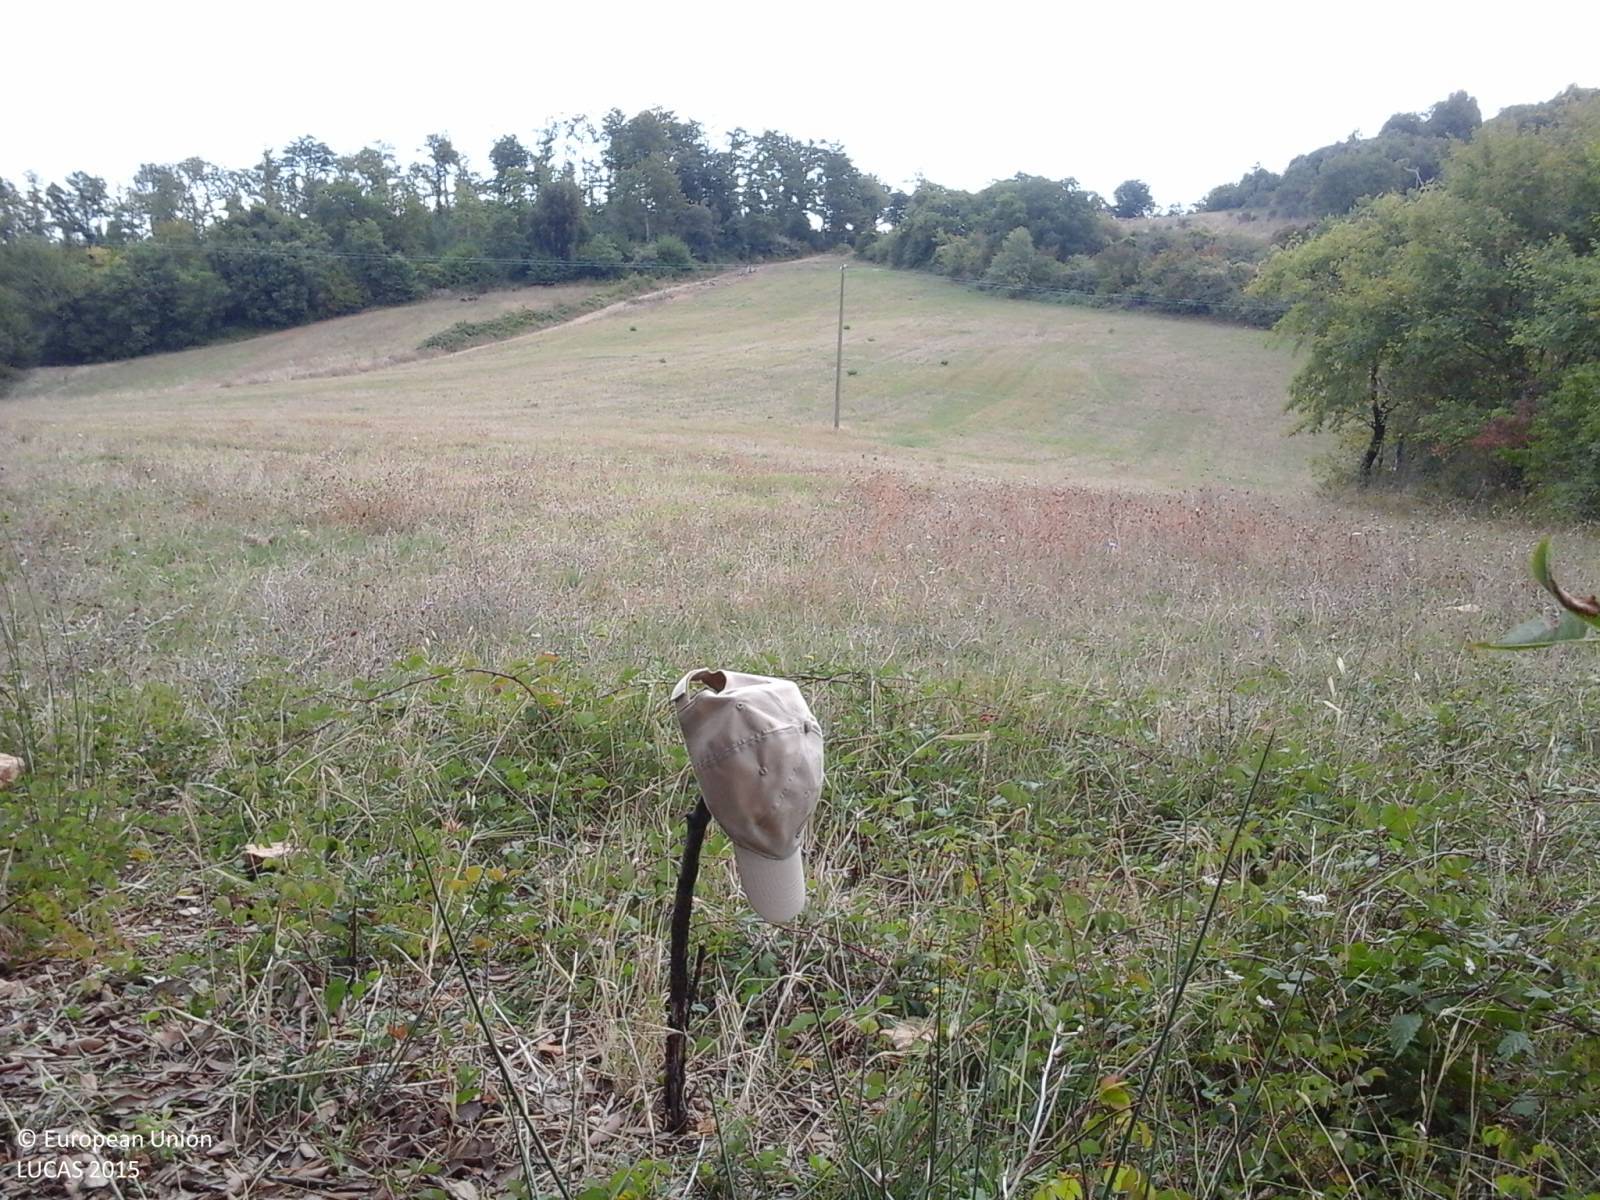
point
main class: Grassland
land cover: Grassland without tree/shrub cover
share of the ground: > 75 %
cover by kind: herbaceous plants 100 %
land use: Agriculture (excluding fallow land and kitchen gardens)
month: September
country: IT
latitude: 43.1333
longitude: 12.3167
